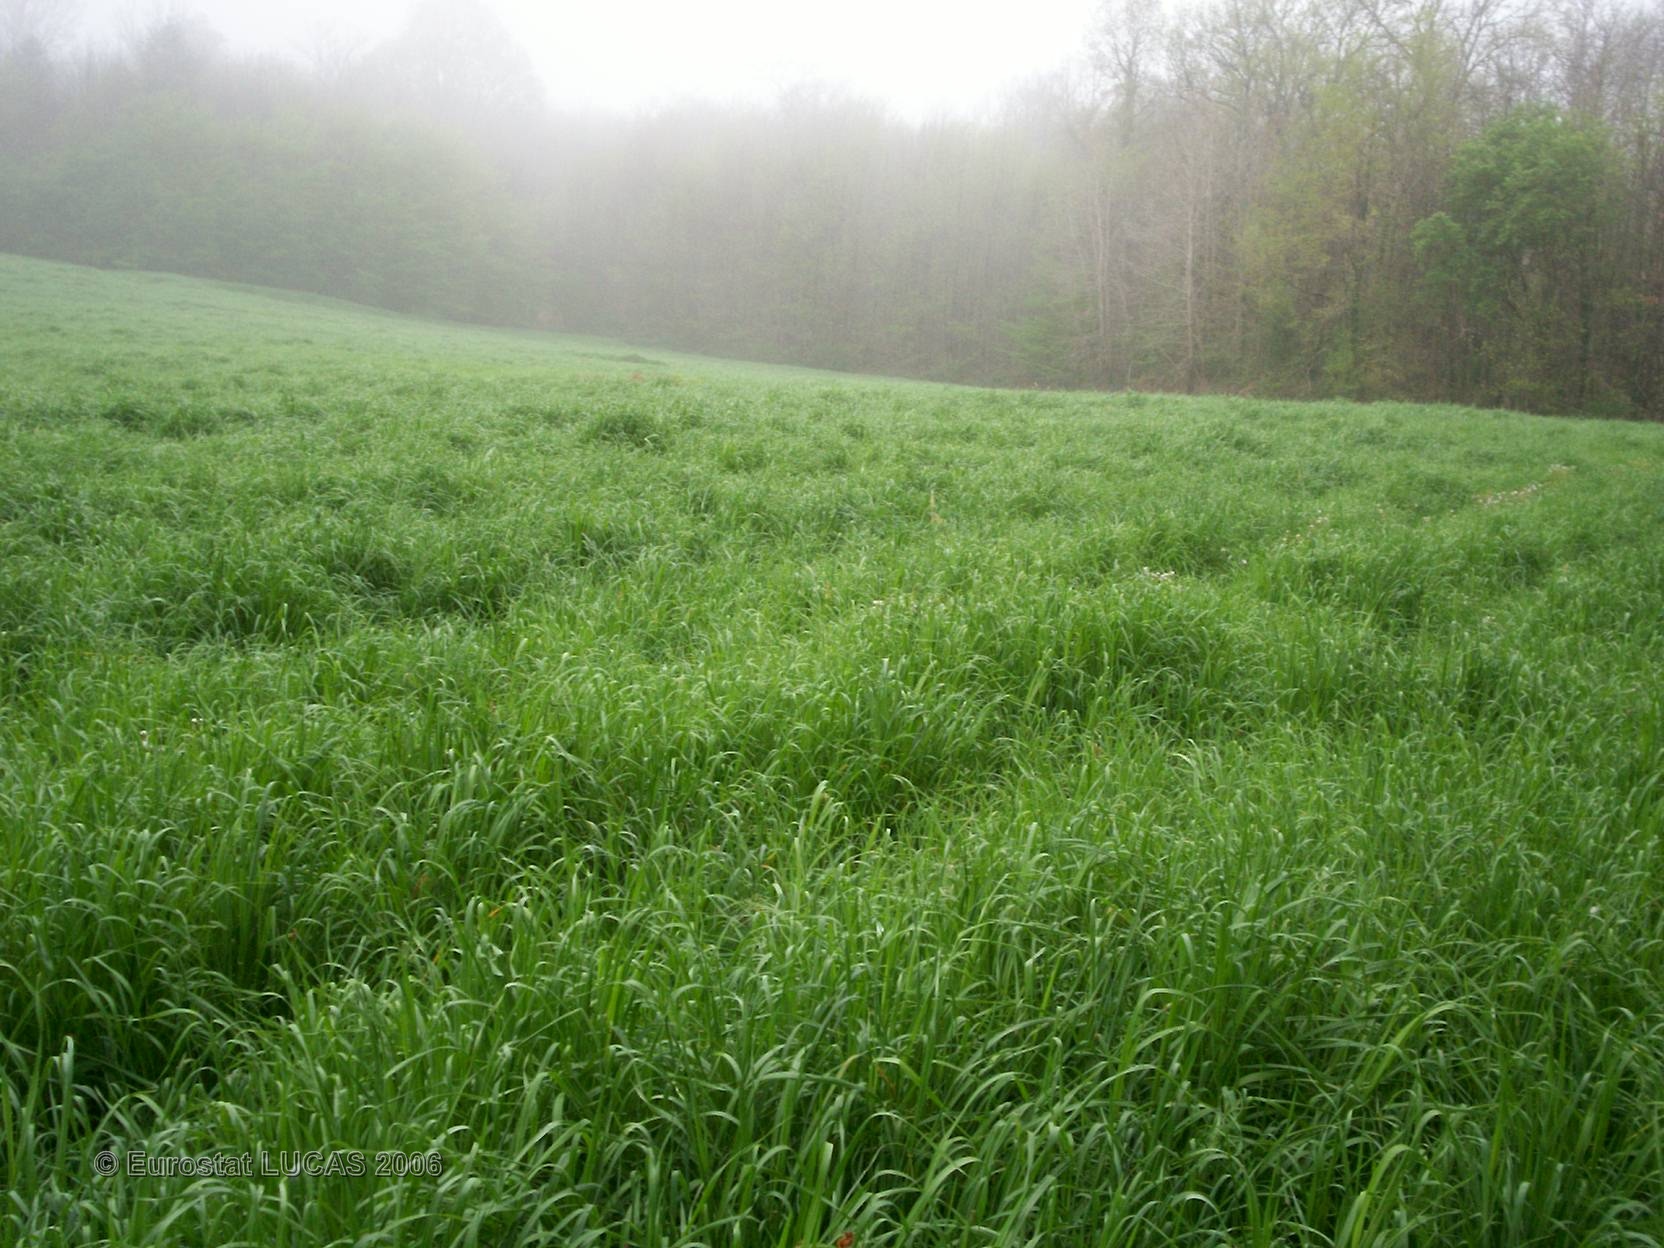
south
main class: Grassland
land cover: Grassland without tree/shrub cover
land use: Agriculture (excluding fallow land and kitchen gardens)
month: April
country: FR
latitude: 45.4639
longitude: 0.5876
